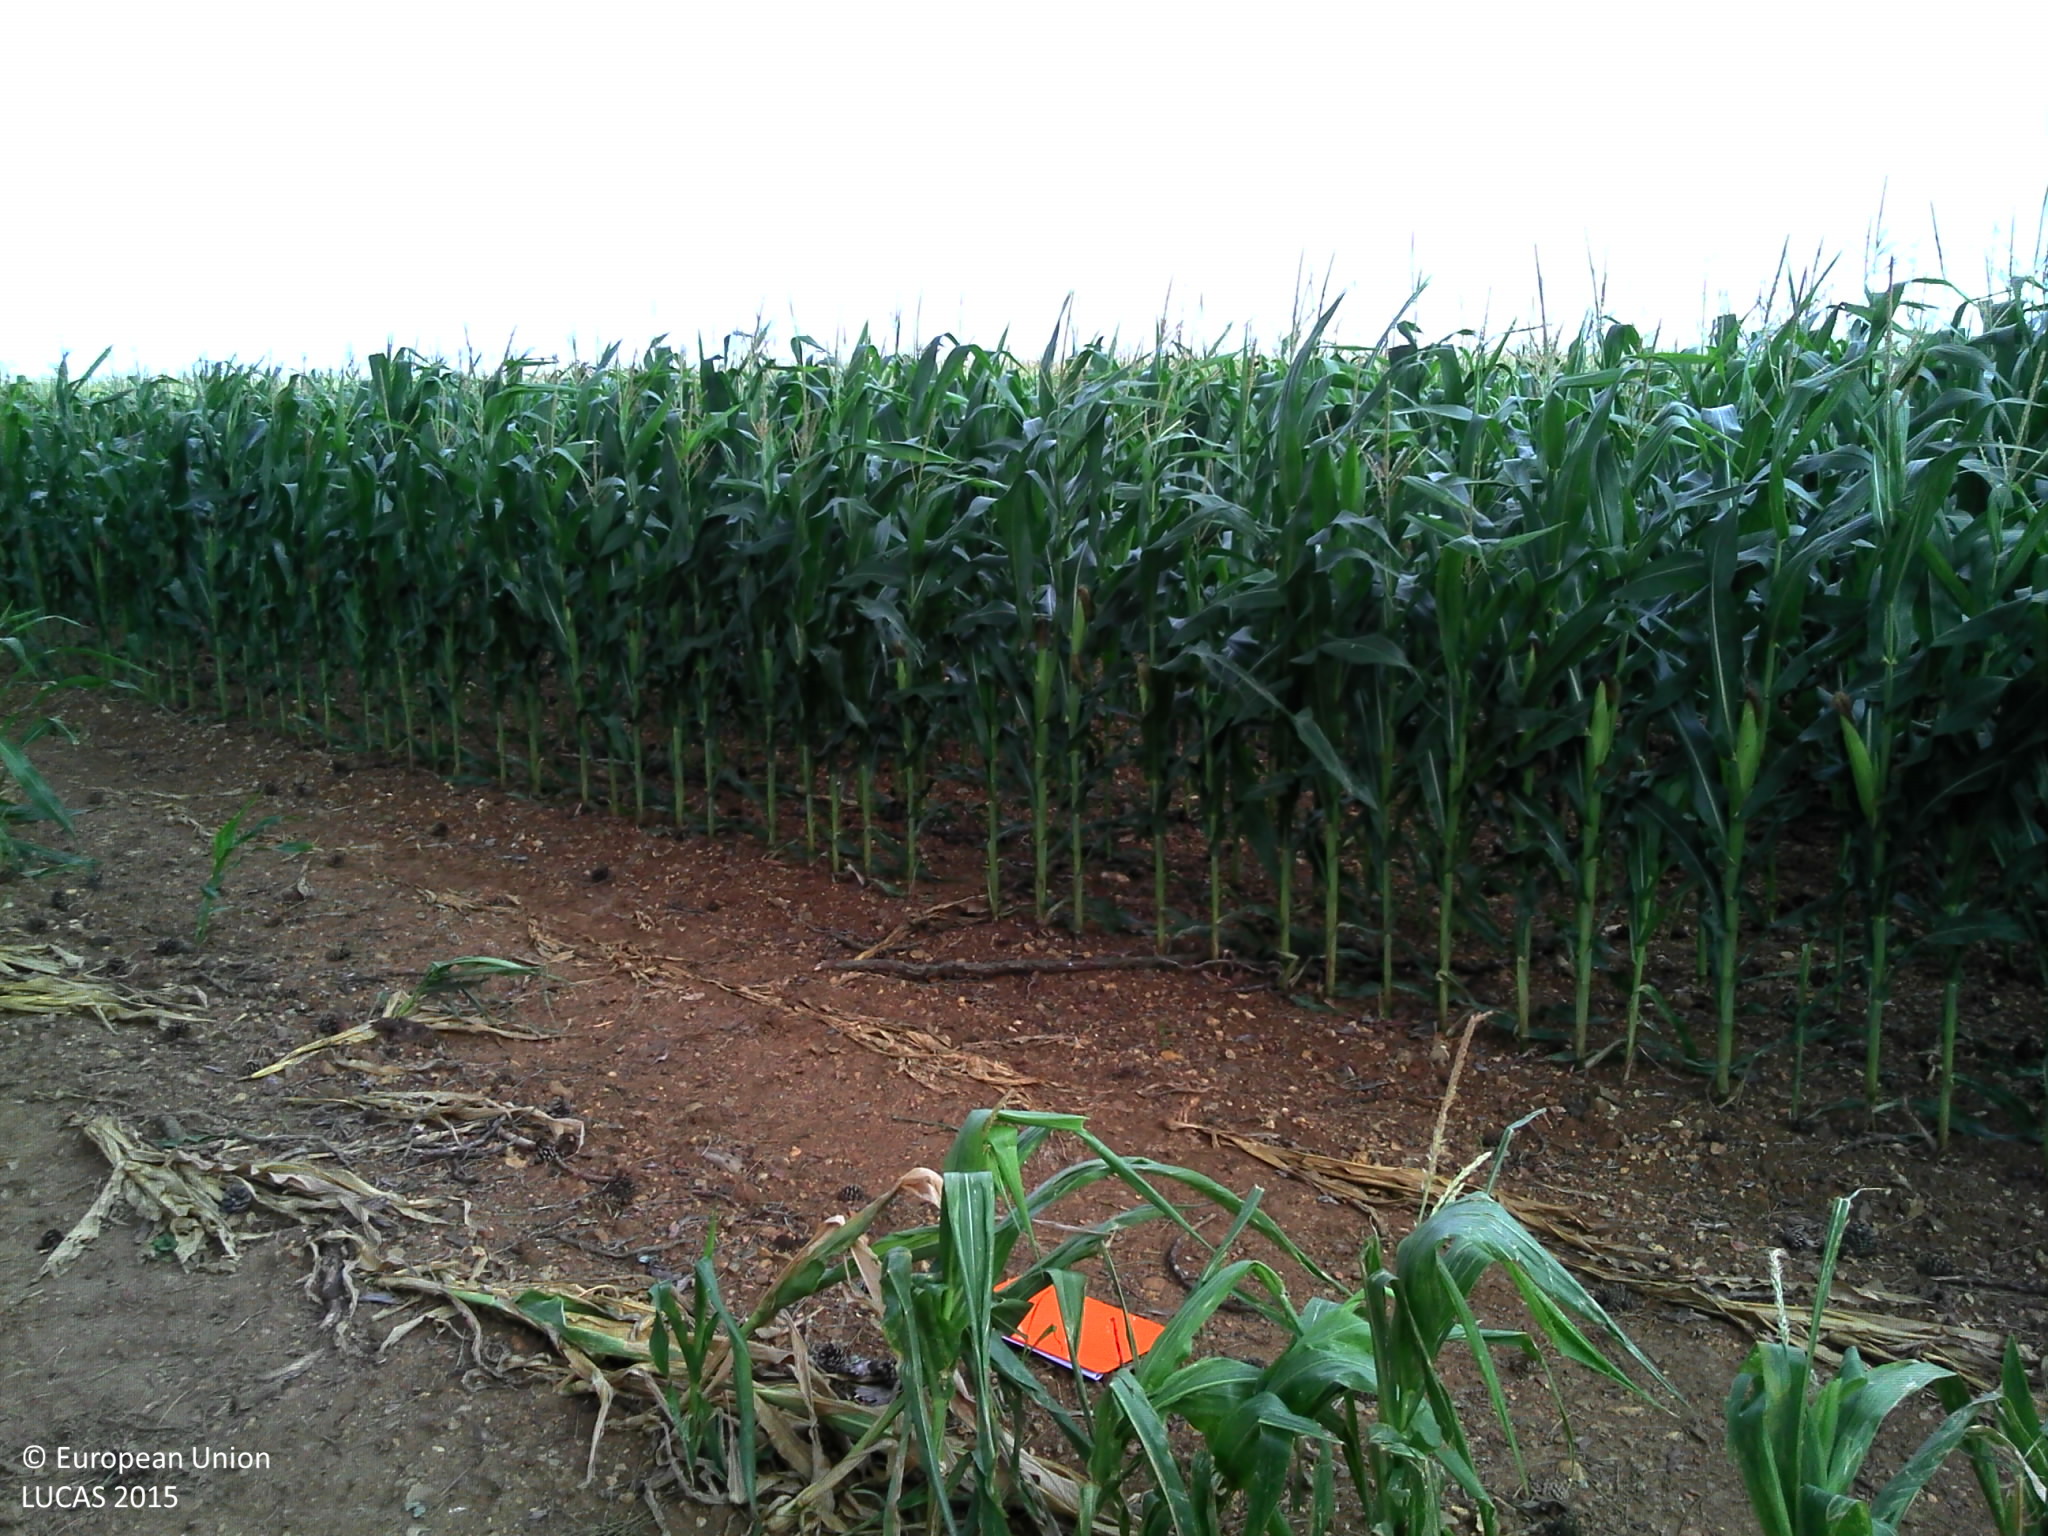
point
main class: Cropland
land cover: Maize
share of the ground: > 75 %
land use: Agriculture (excluding fallow land and kitchen gardens)
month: July
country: FR
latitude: 46.3424
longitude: 0.2758
